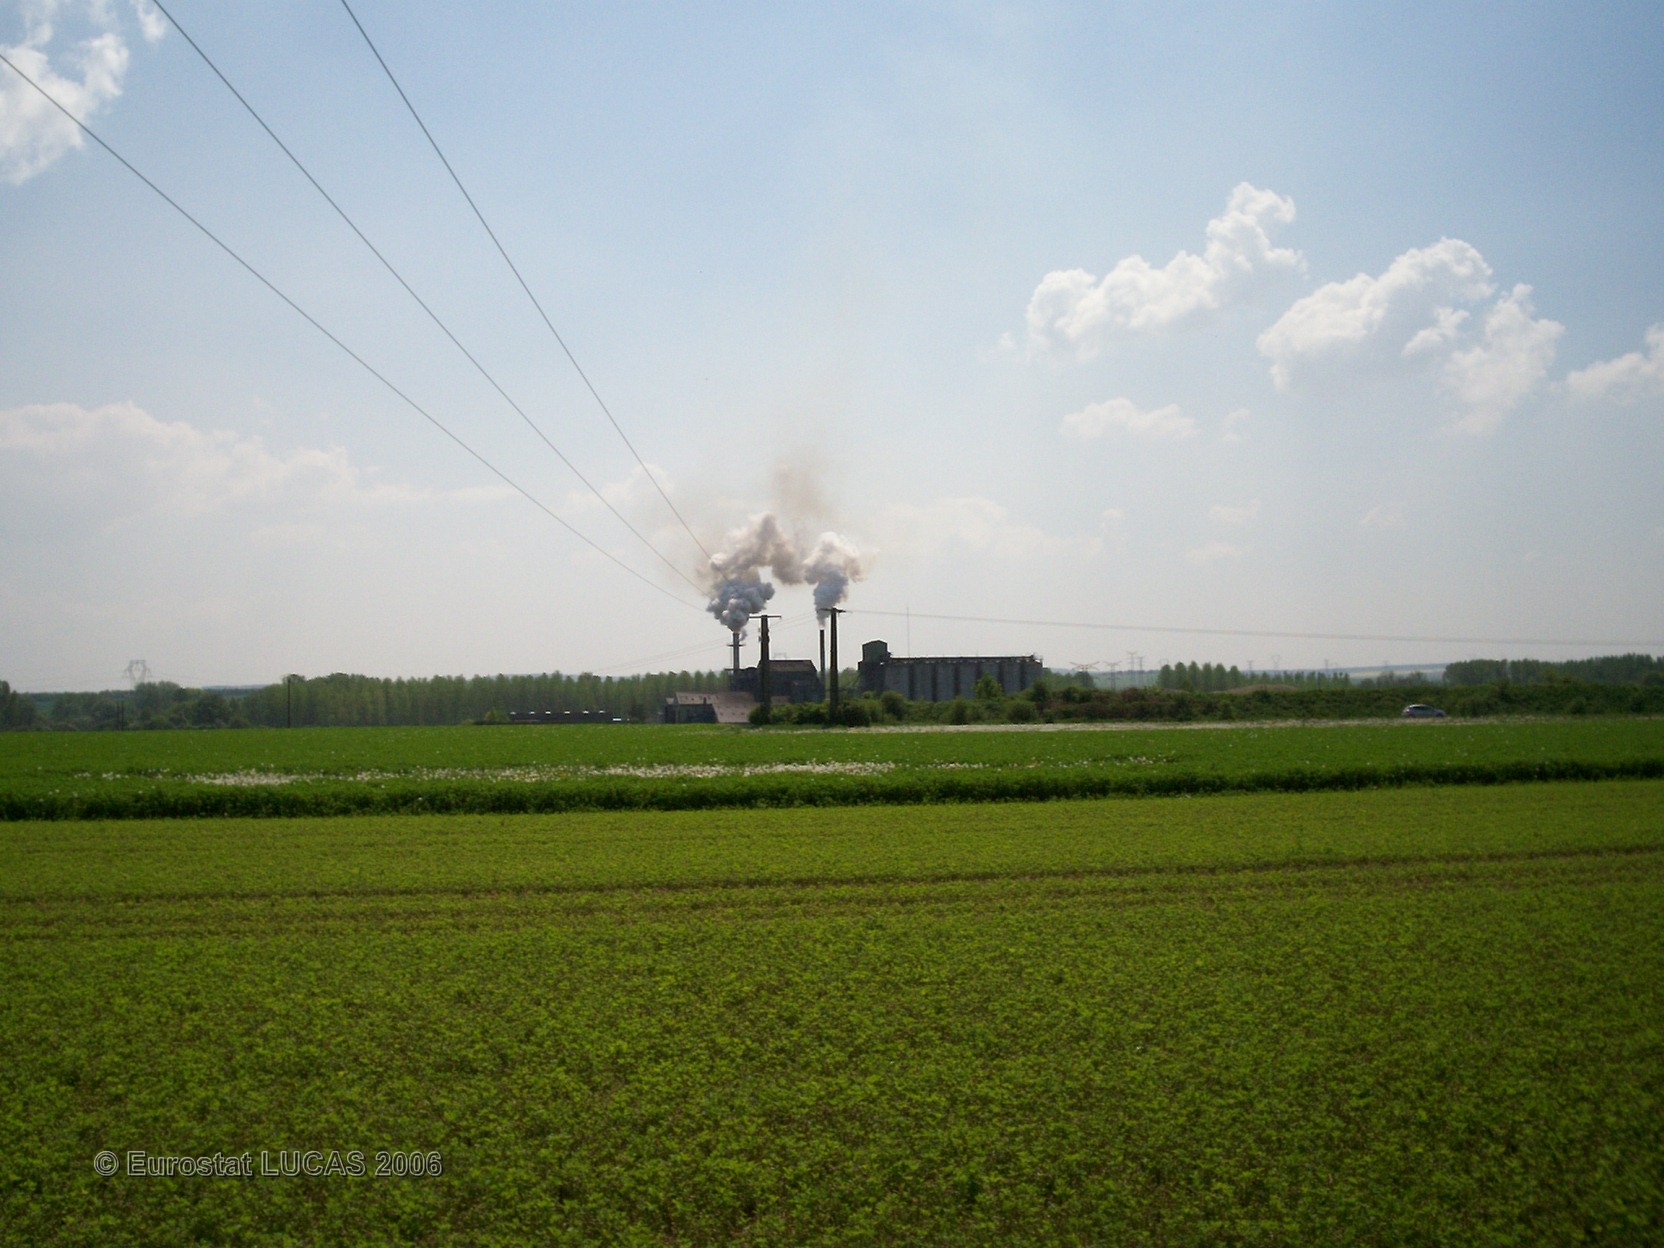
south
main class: Cropland
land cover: Lucerne
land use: Agriculture (excluding fallow land and kitchen gardens)
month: May
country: FR
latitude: 49.3047
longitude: 4.3434
